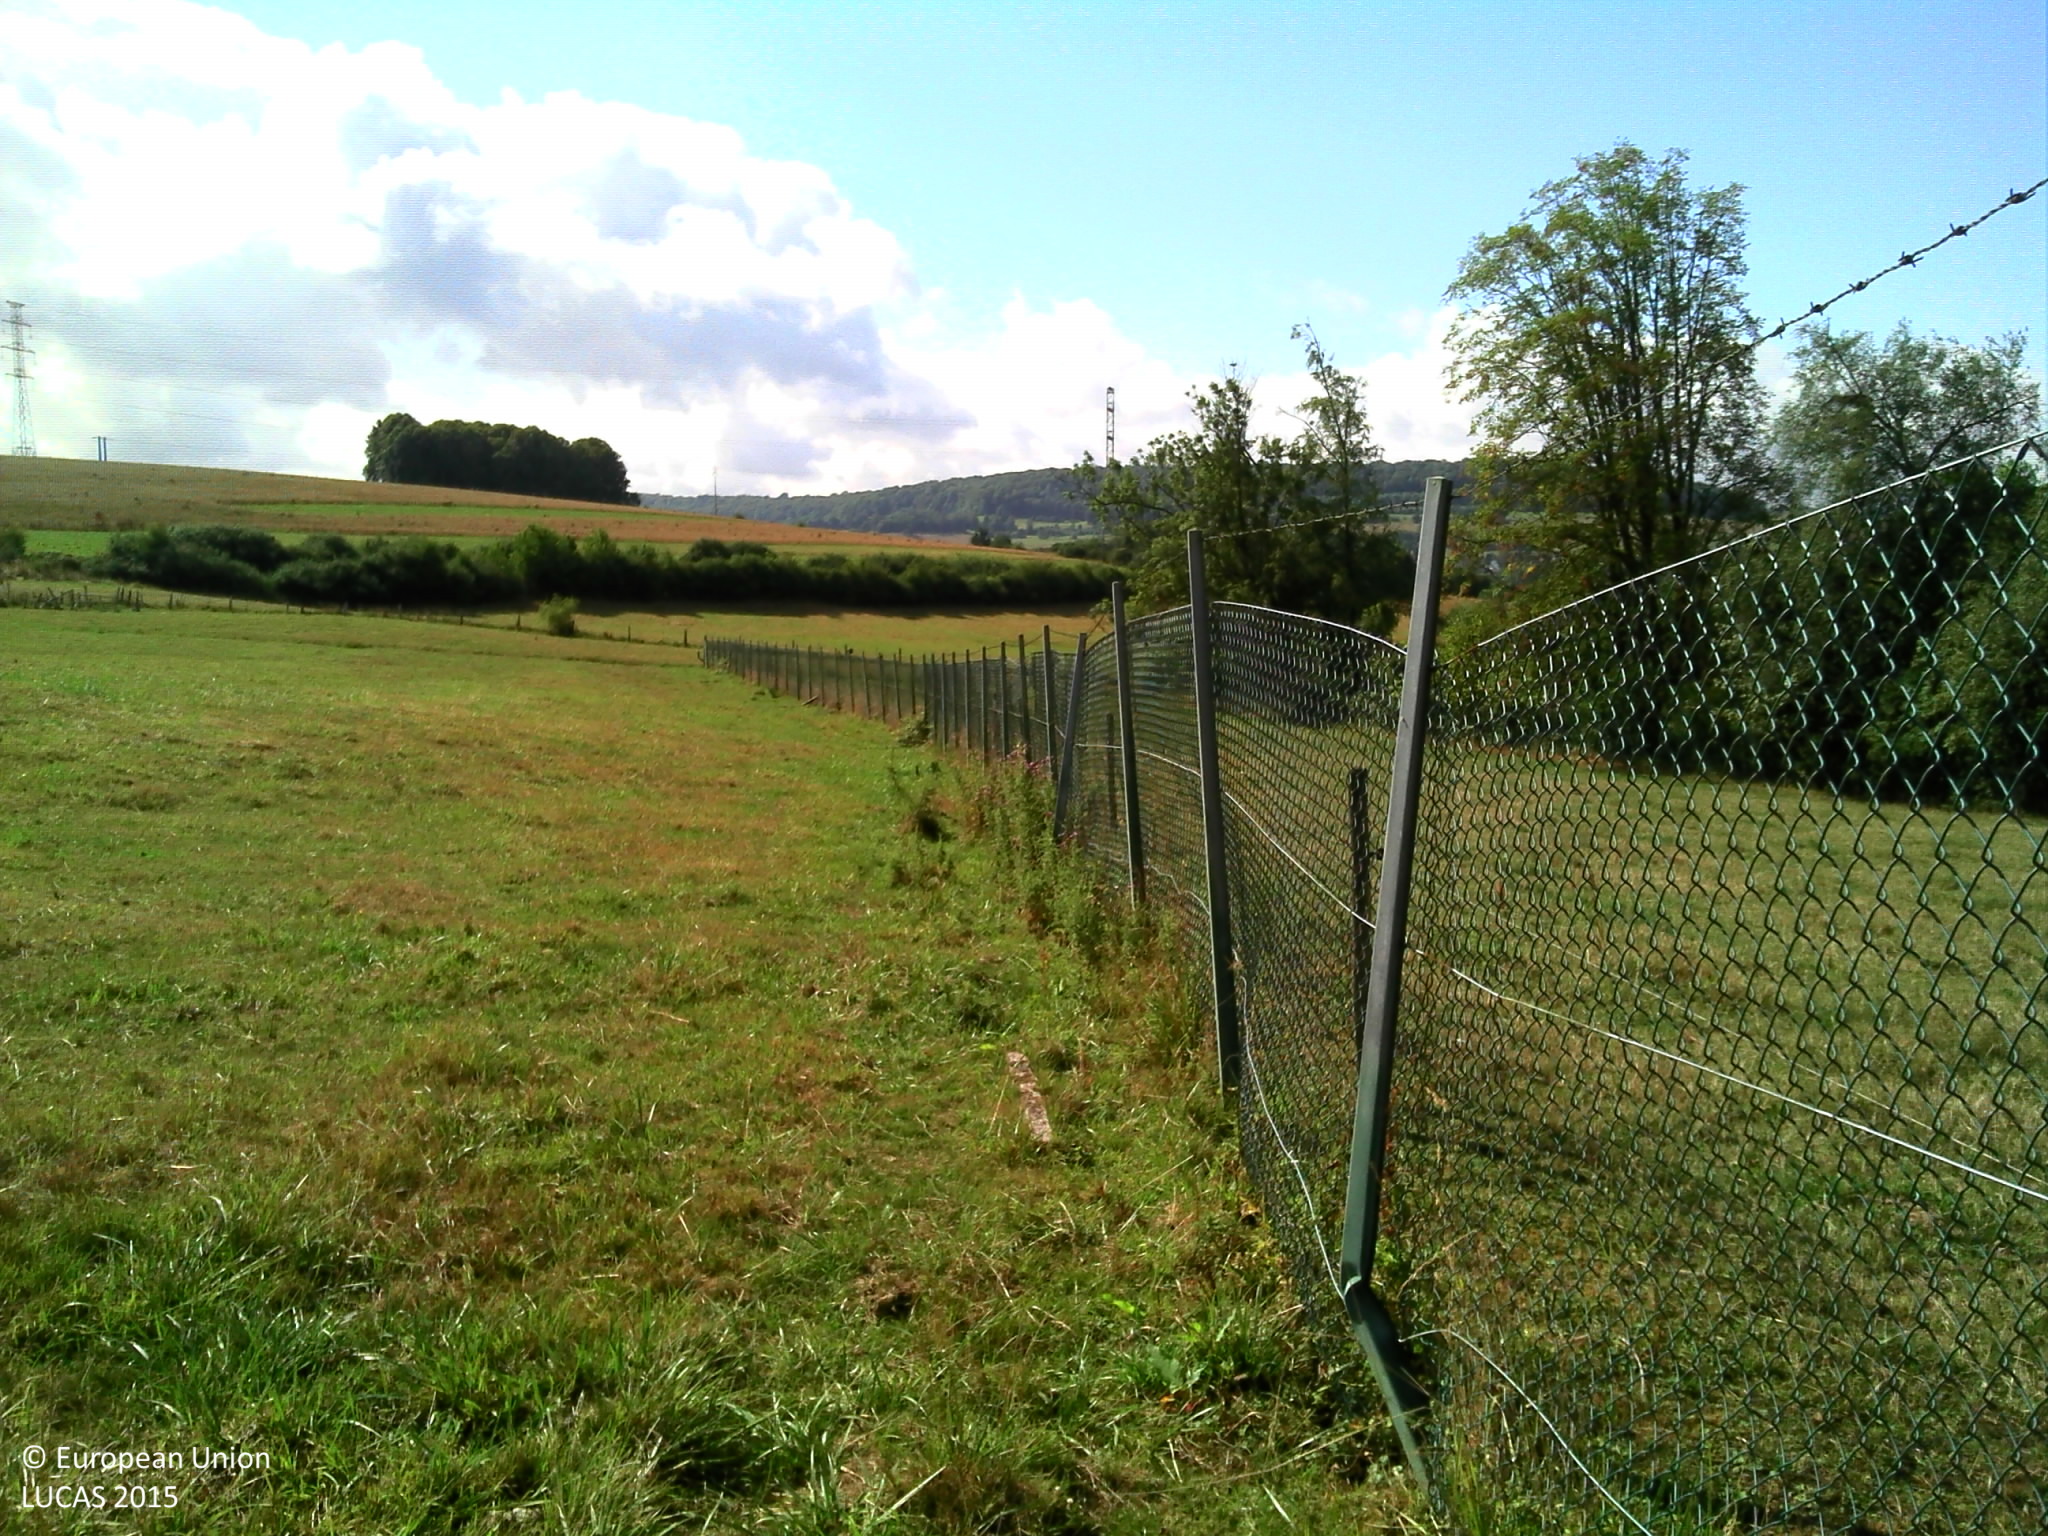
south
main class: Grassland
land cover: Grassland with sparse tree/shrub cover
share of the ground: > 75 %
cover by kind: herbaceous plants 95 %, broadleaved forest trees 5 %
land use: Amenities, museums, leisure
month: July
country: BE
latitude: 49.5607
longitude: 5.6438
